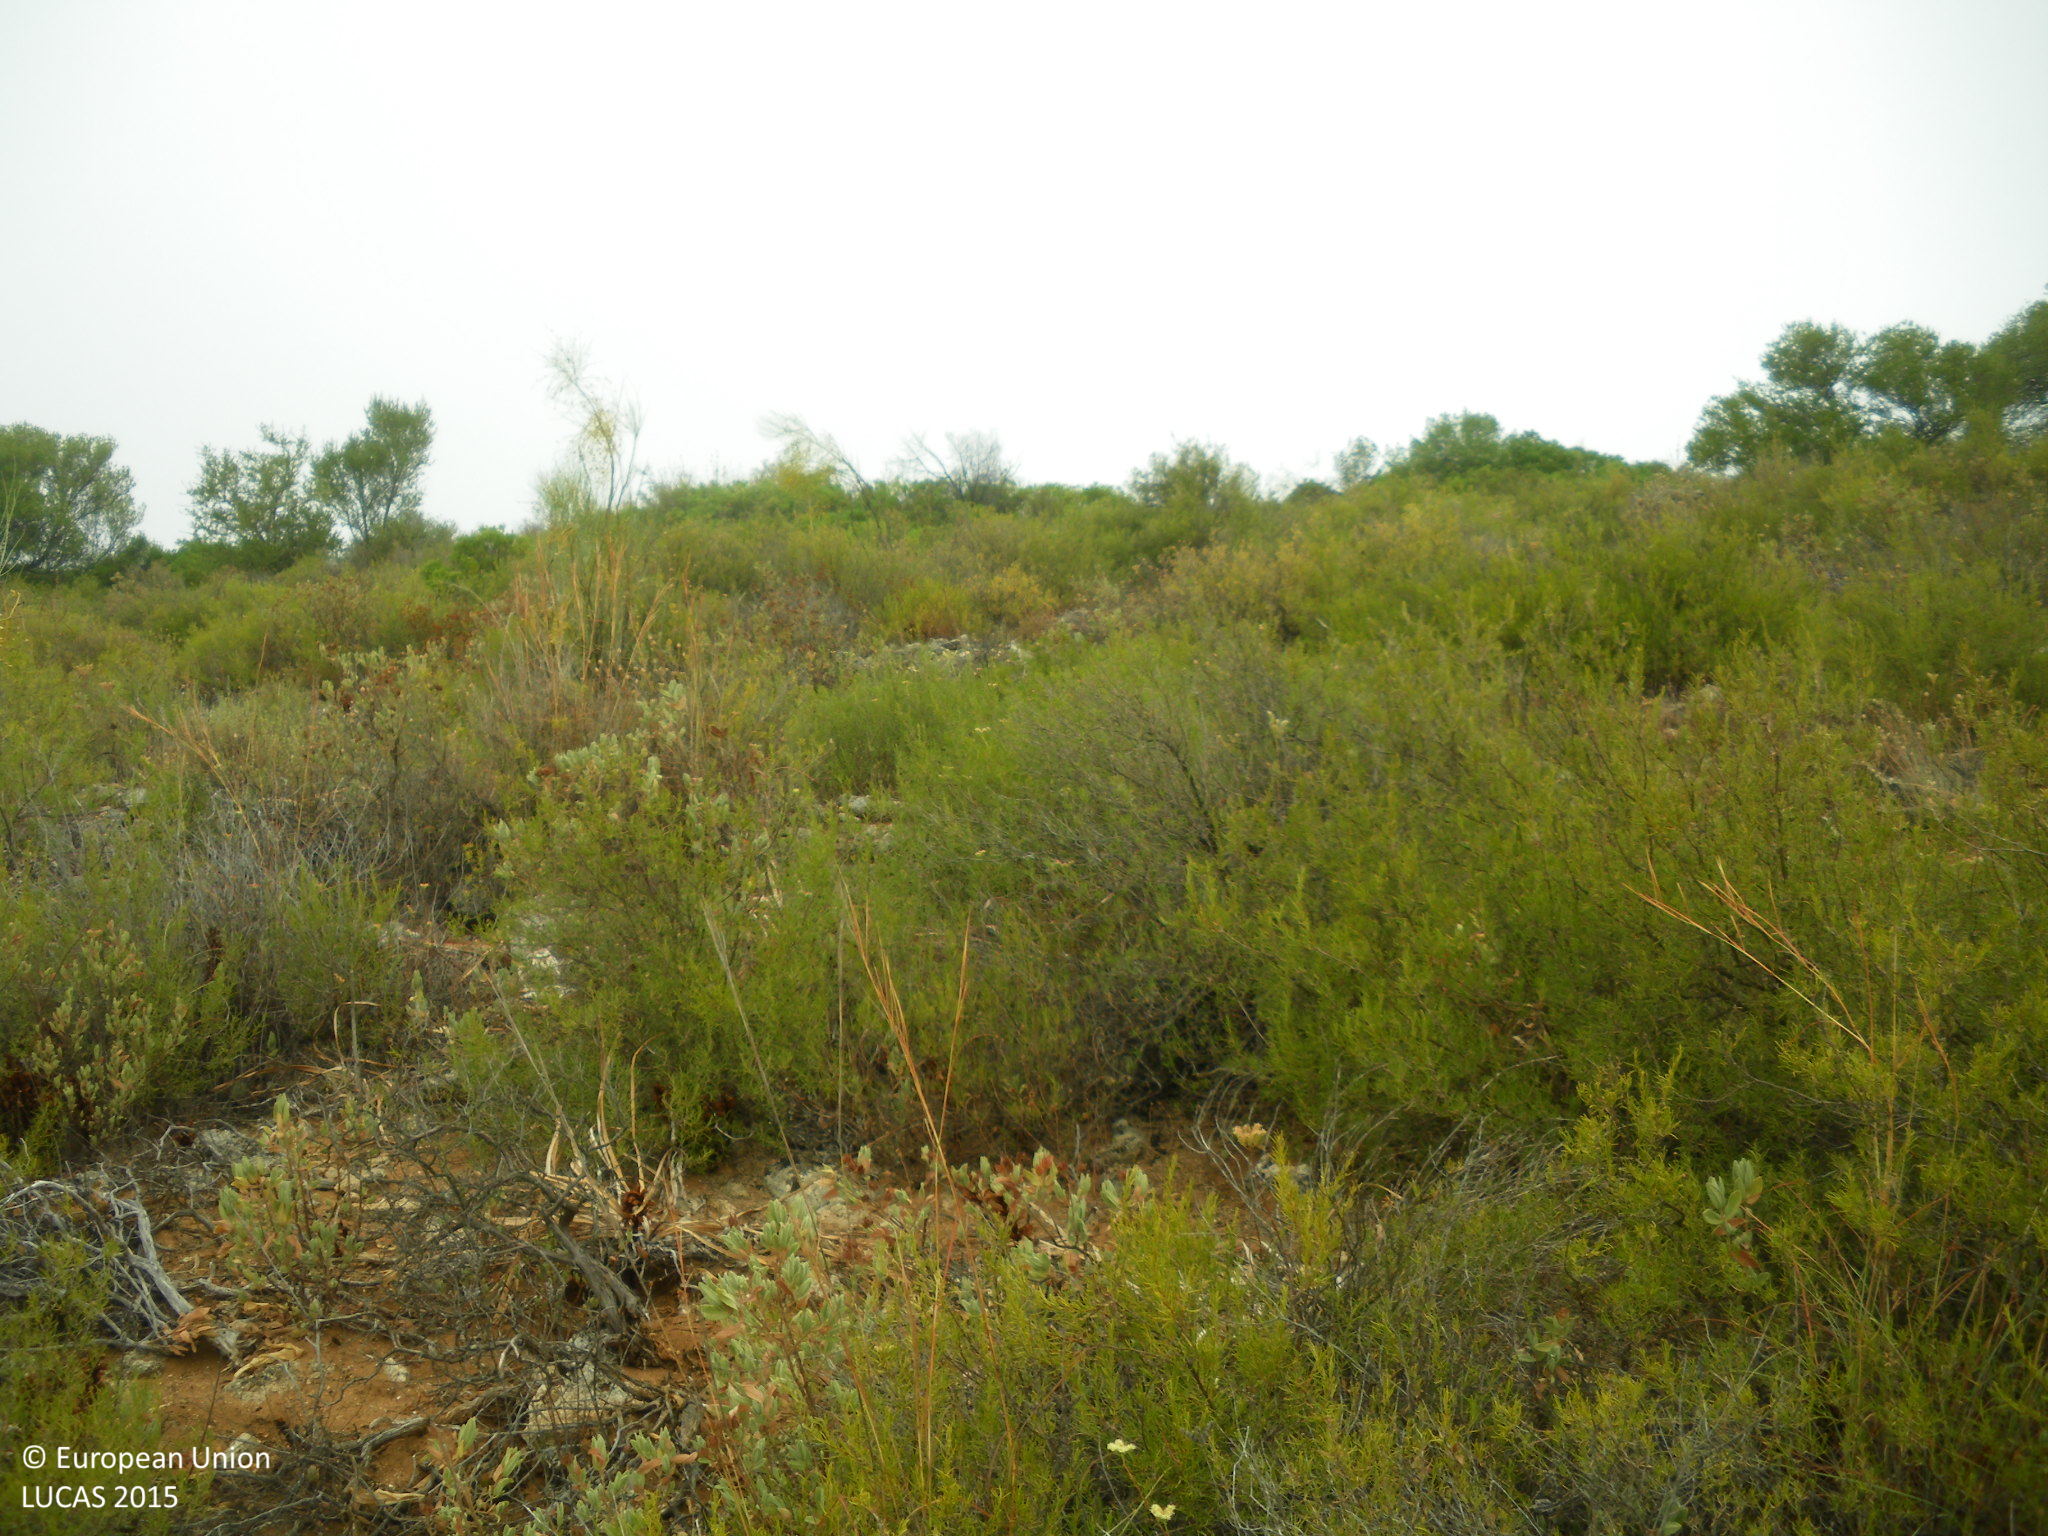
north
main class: Shrubland
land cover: Shrubland with sparse tree cover
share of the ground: > 75 %
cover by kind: shrubs 70 %, unconsolidated bare surface 15 %, herbaceous plants 10 %, broadleaved forest trees 5 %
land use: Semi-natural and natural areas not in use
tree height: < 5 m
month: July
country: ES
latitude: 36.7764
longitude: -5.7501
